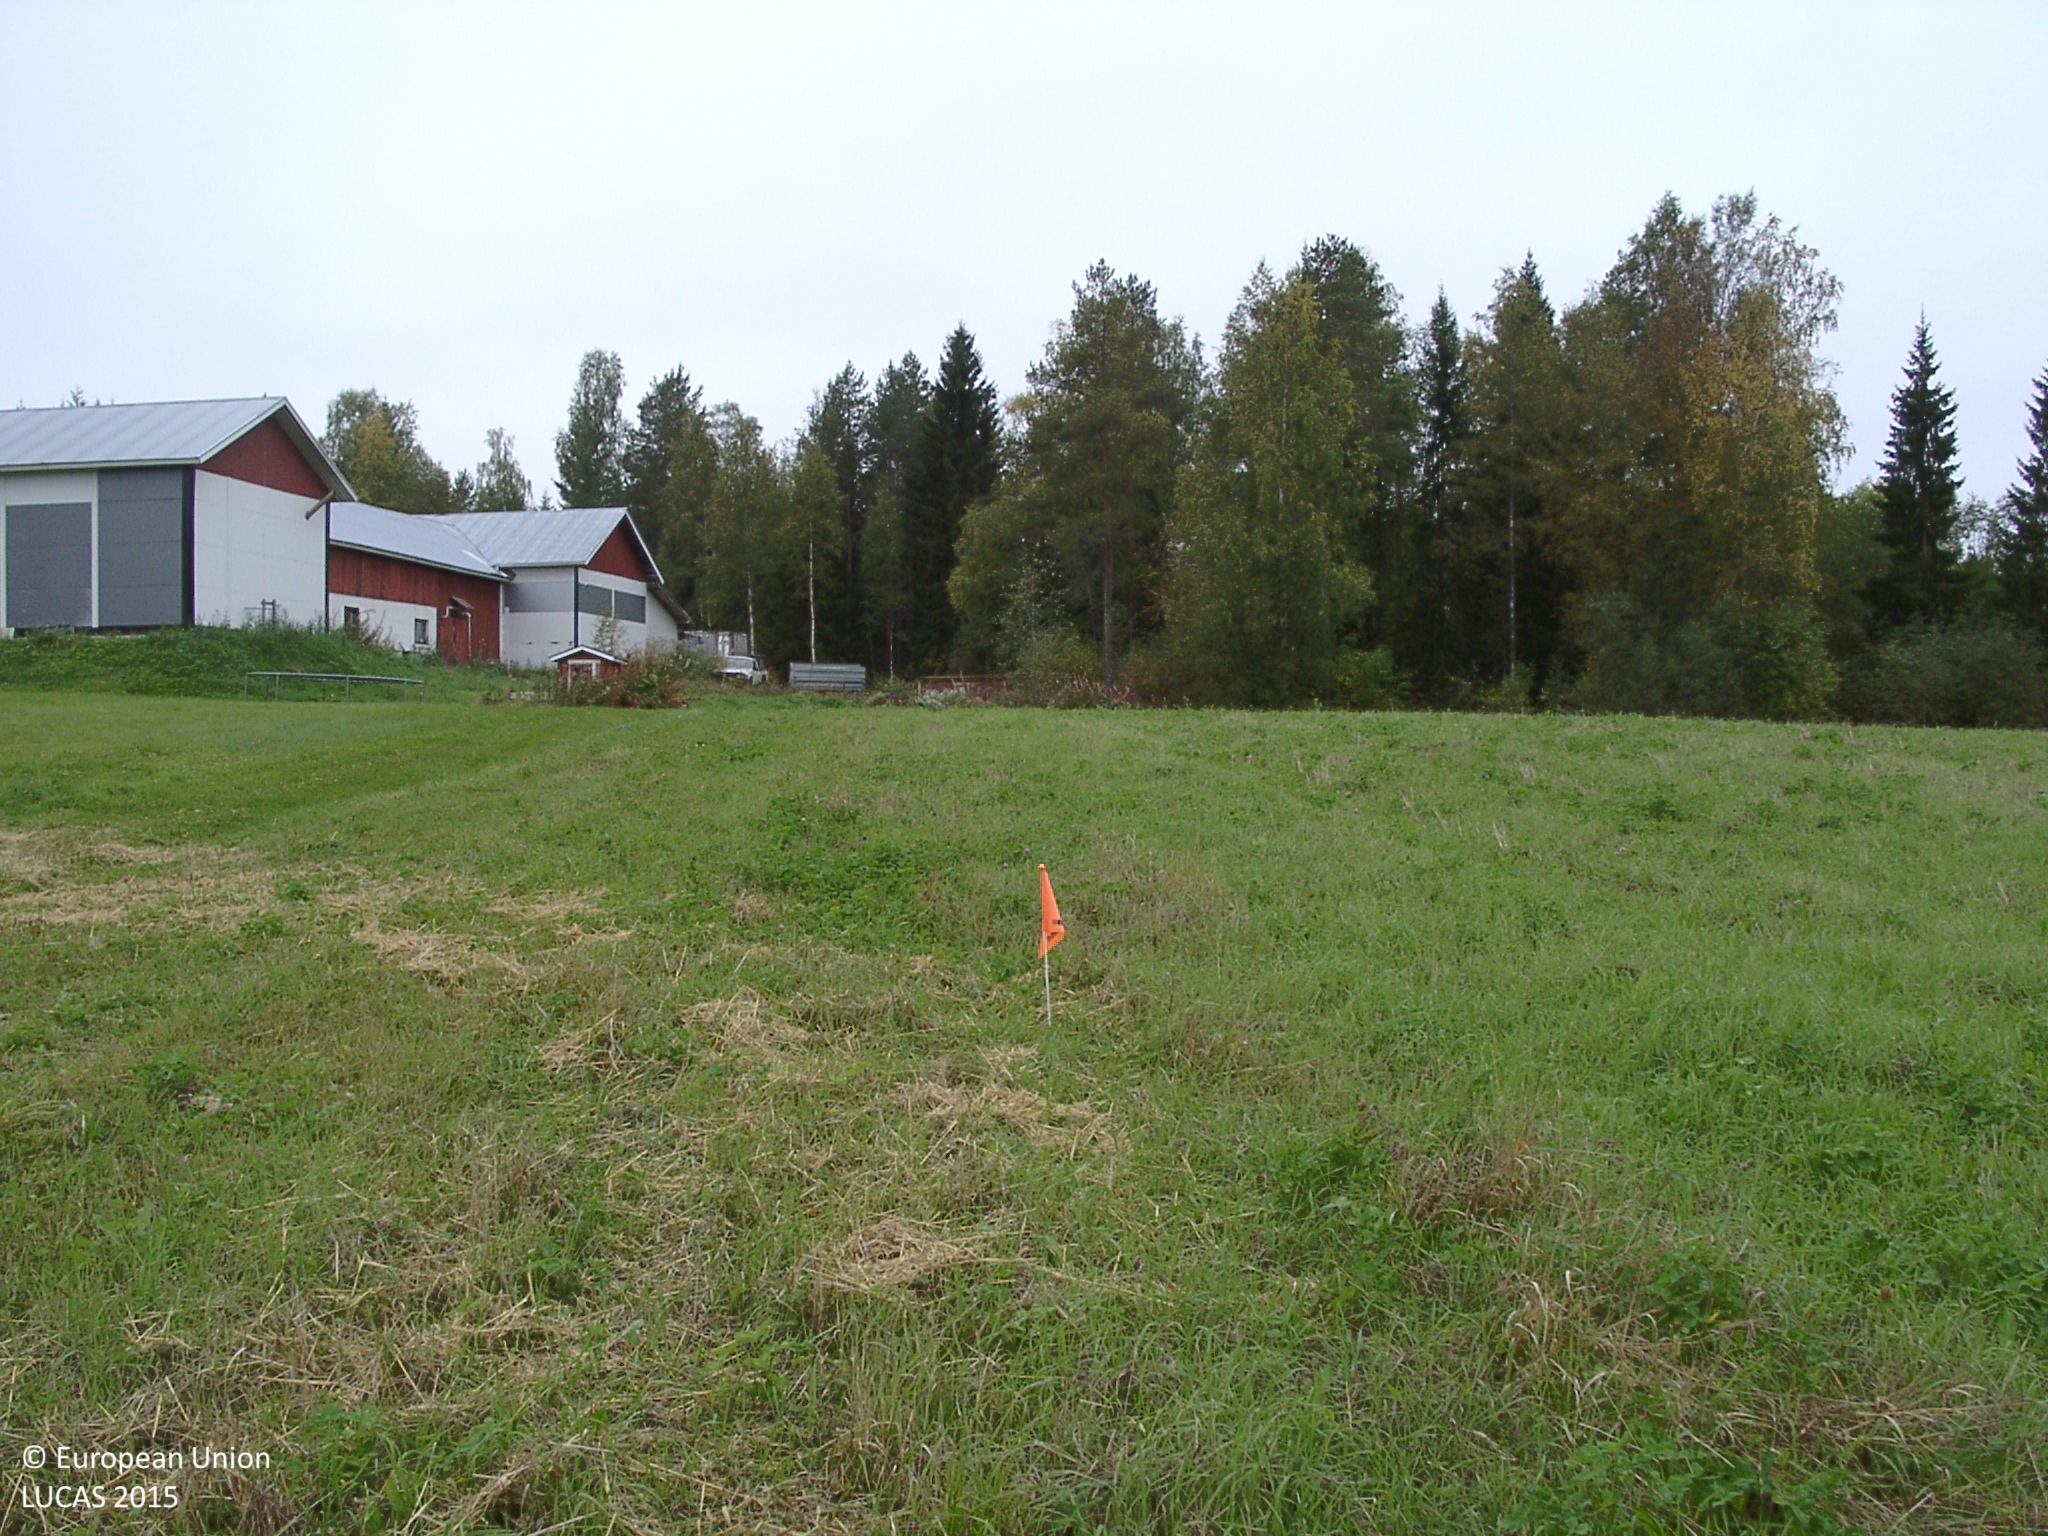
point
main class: Cropland
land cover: Other leguminous and mixtures for fodder
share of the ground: > 75 %
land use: Agriculture (excluding fallow land and kitchen gardens)
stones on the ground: < 10 %
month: September
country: FI
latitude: 62.5781
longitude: 25.6663
